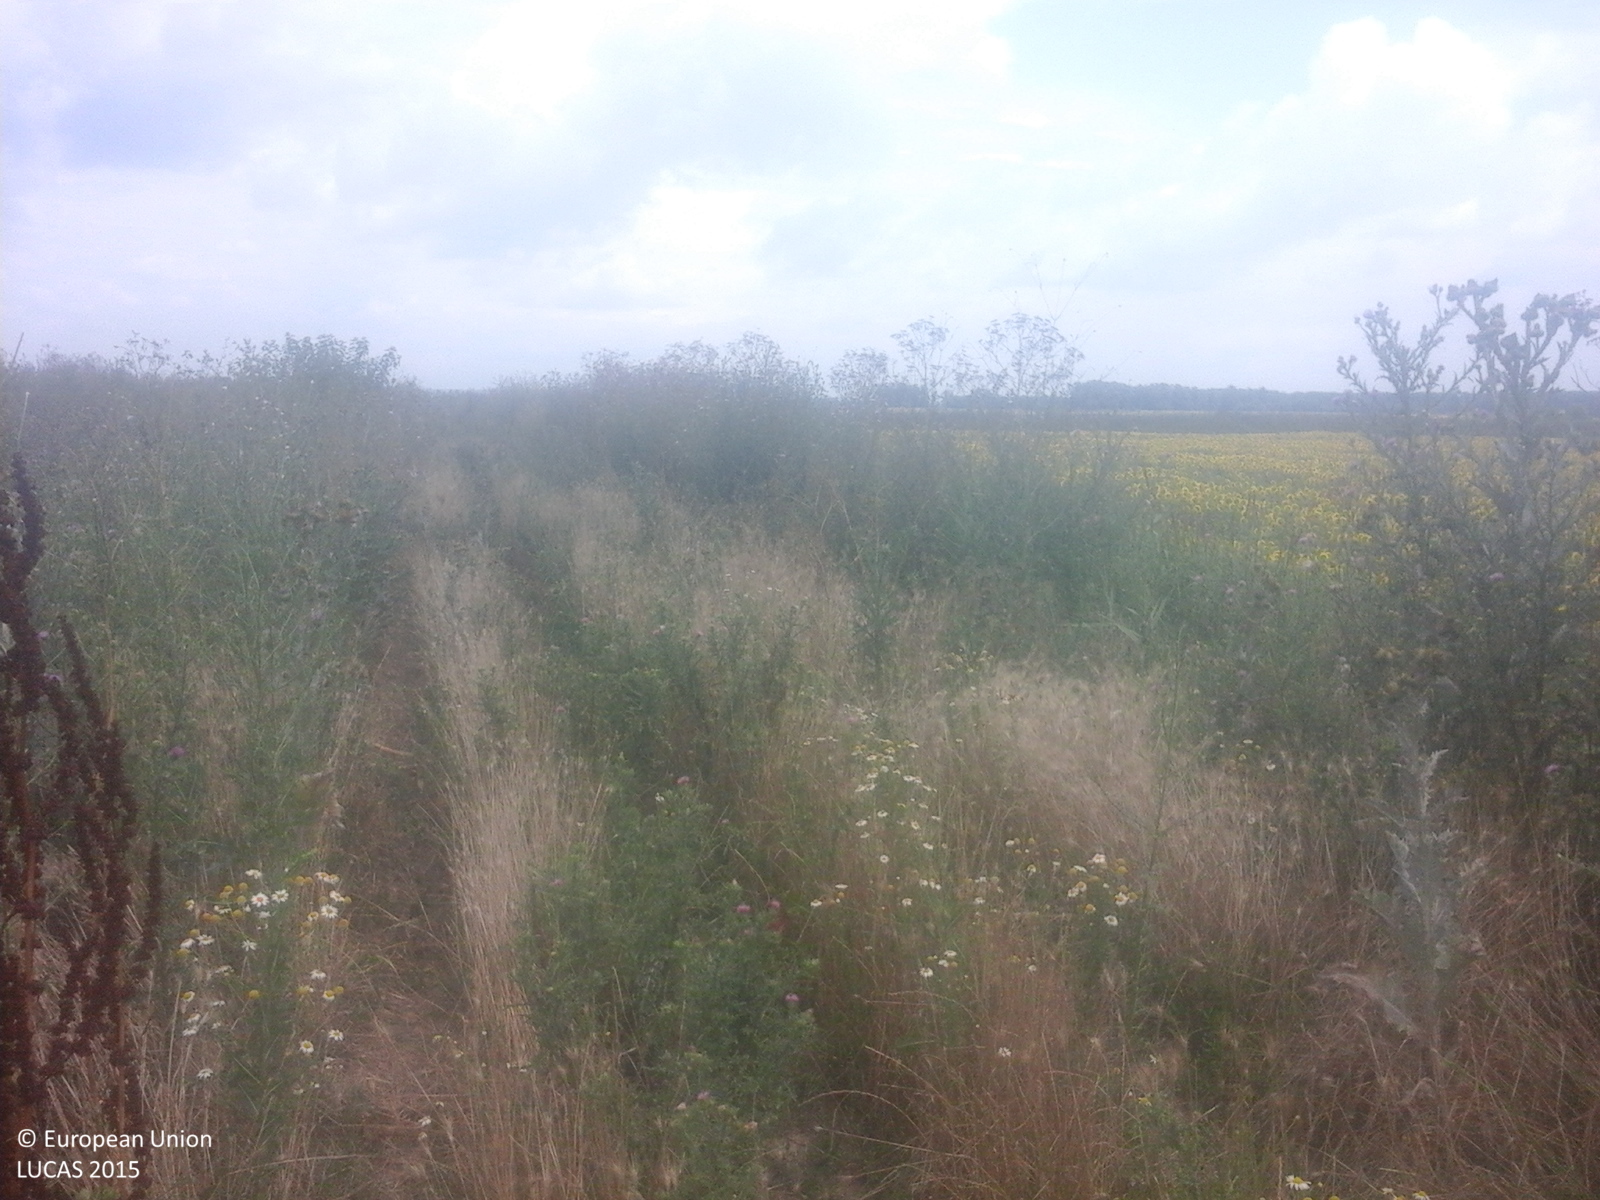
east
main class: Grassland
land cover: Spontaneously vegetated surfaces
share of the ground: > 75 %
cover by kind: herbaceous plants 100 %
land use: Semi-natural and natural areas not in use
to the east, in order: Spontaneously vegetated surfaces; Ditches and canals; Tracks; Spontaneously vegetated surfaces; Sunflower; Spontaneously vegetated surfaces; Ditches and canals; Spontaneously vegetated surfaces; Tracks; Spontaneously vegetated surfaces; Ditches and canals; Spontaneously vegetated surfaces; Lucerne; Spontaneously vegetated surfaces; Common wheat; Maize
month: July
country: RO
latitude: 43.7673
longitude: 24.7397
